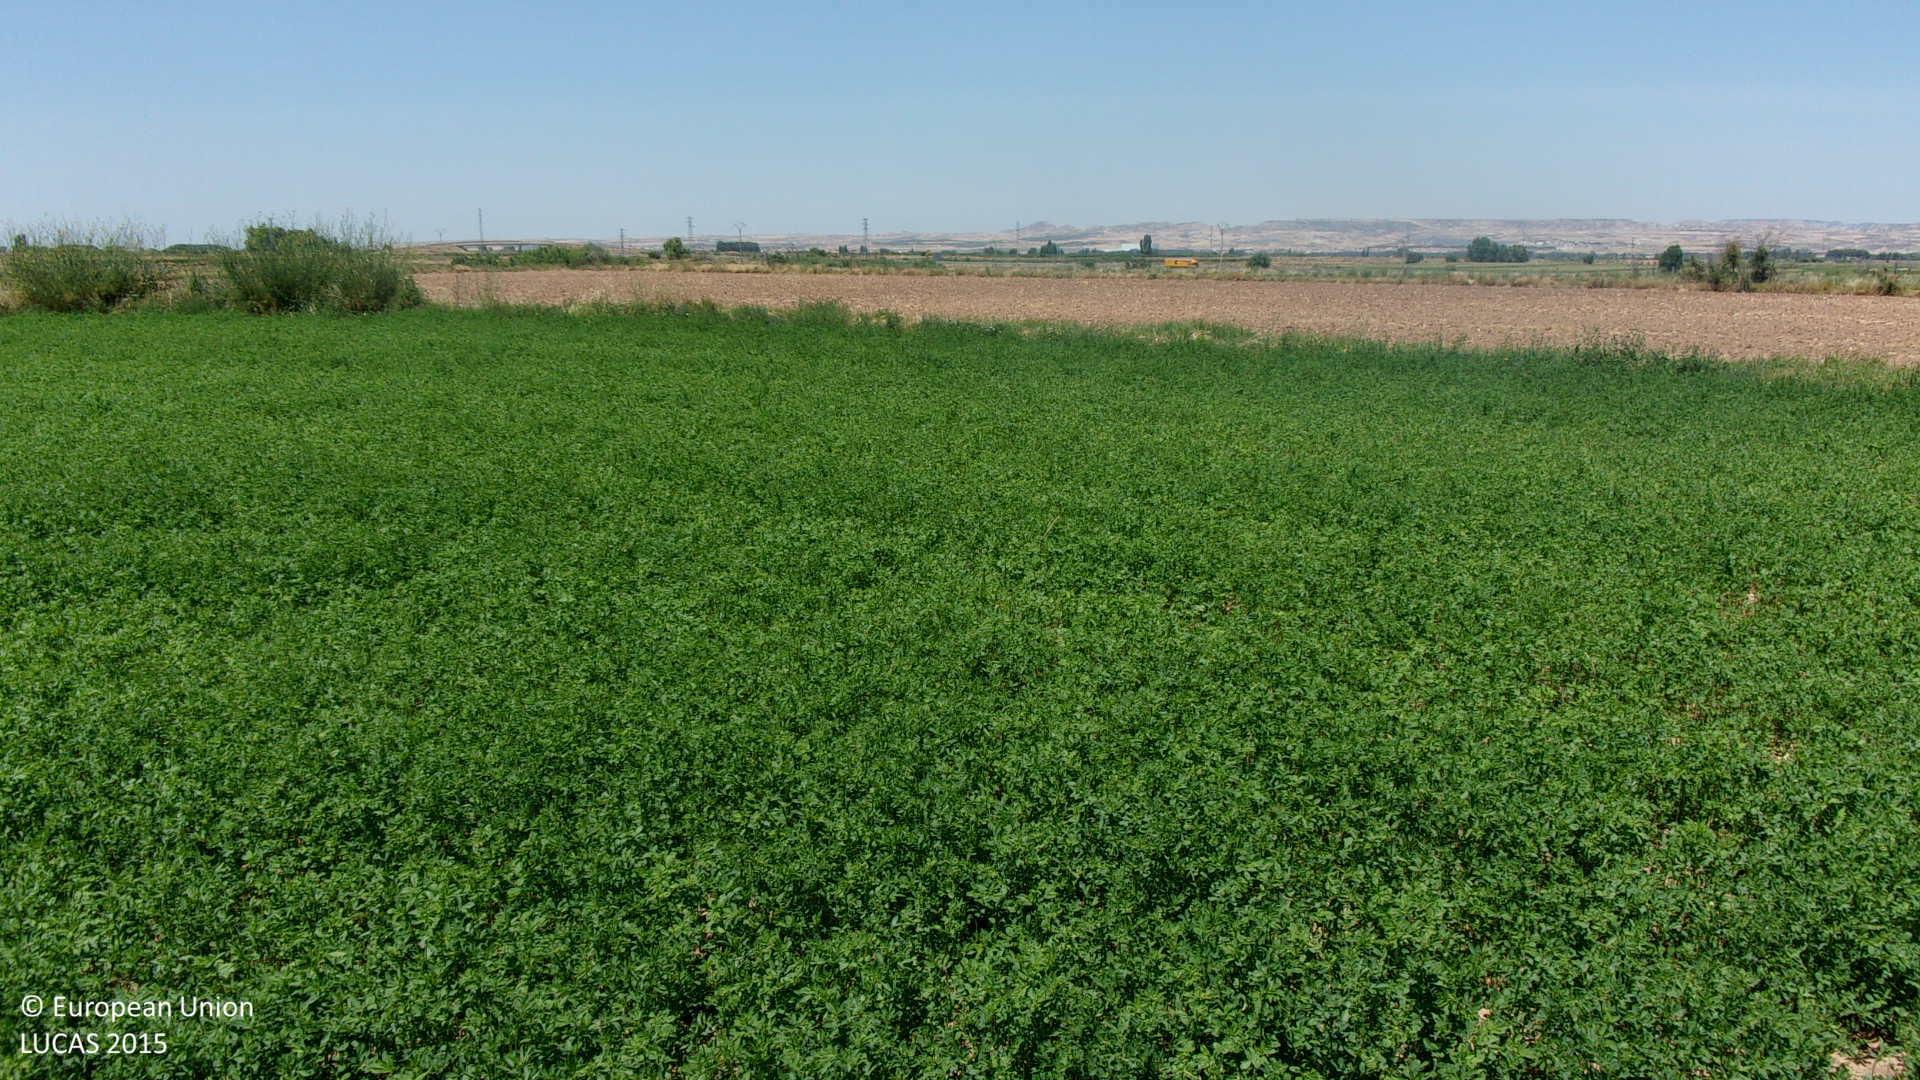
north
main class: Cropland
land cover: Lucerne
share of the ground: > 75 %
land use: Agriculture (excluding fallow land and kitchen gardens)
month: July
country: ES
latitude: 41.9598
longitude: -1.5039
